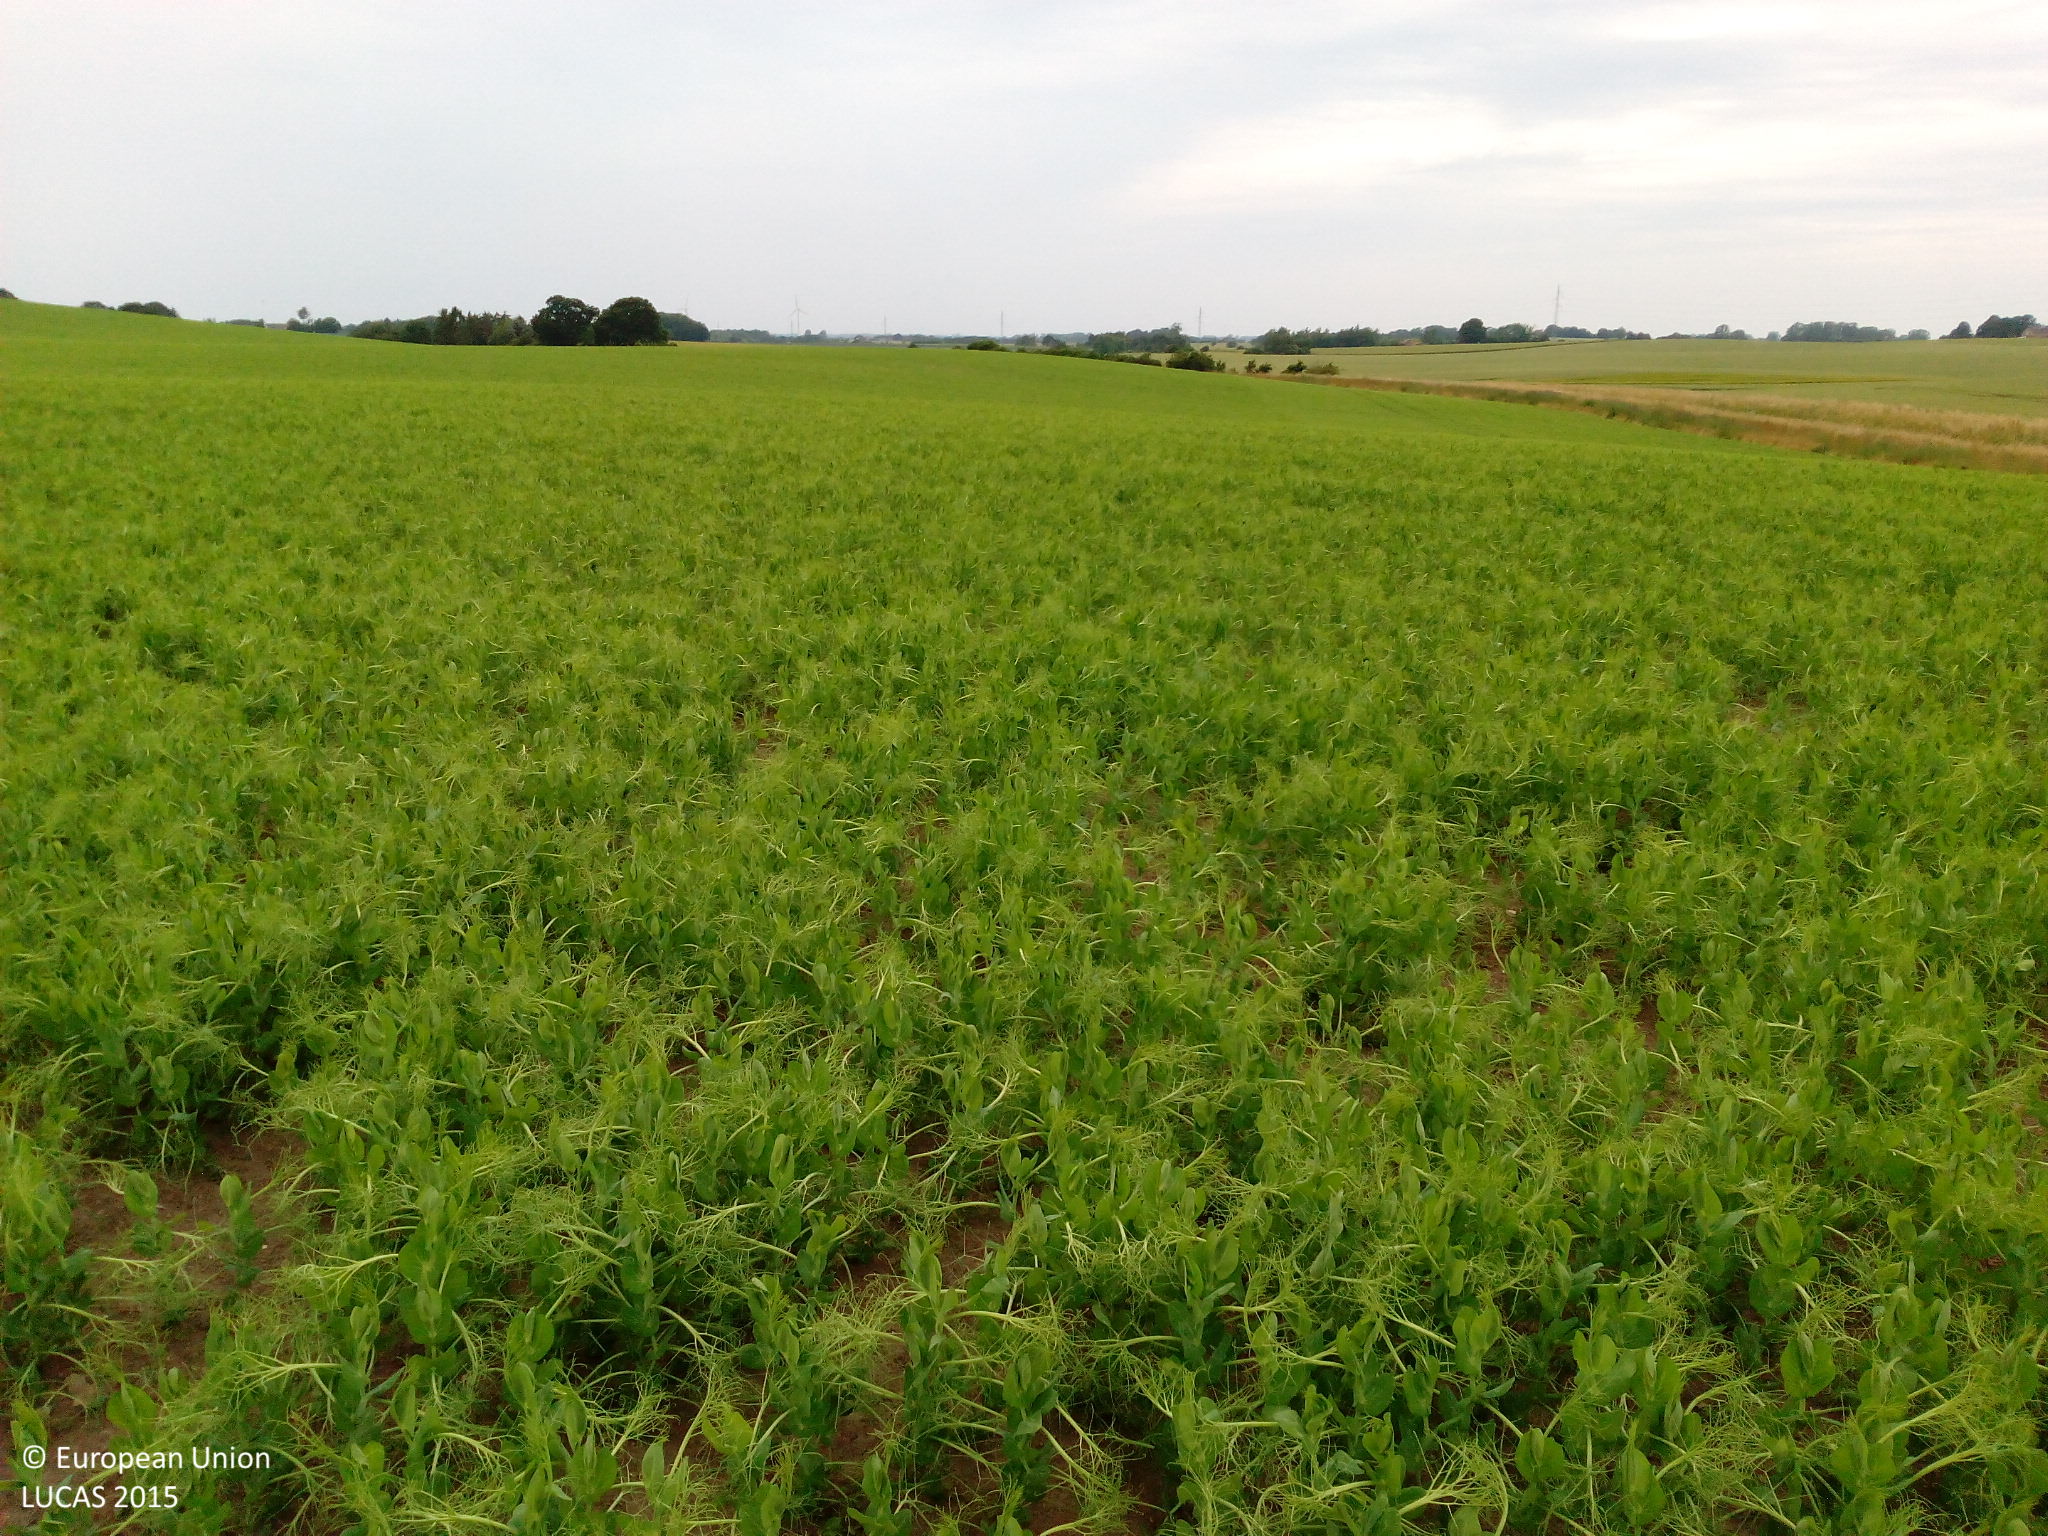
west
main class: Cropland
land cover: Dry pulses
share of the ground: > 75 %
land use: Agriculture (excluding fallow land and kitchen gardens)
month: July
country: DK
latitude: 55.2247
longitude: 11.6180
